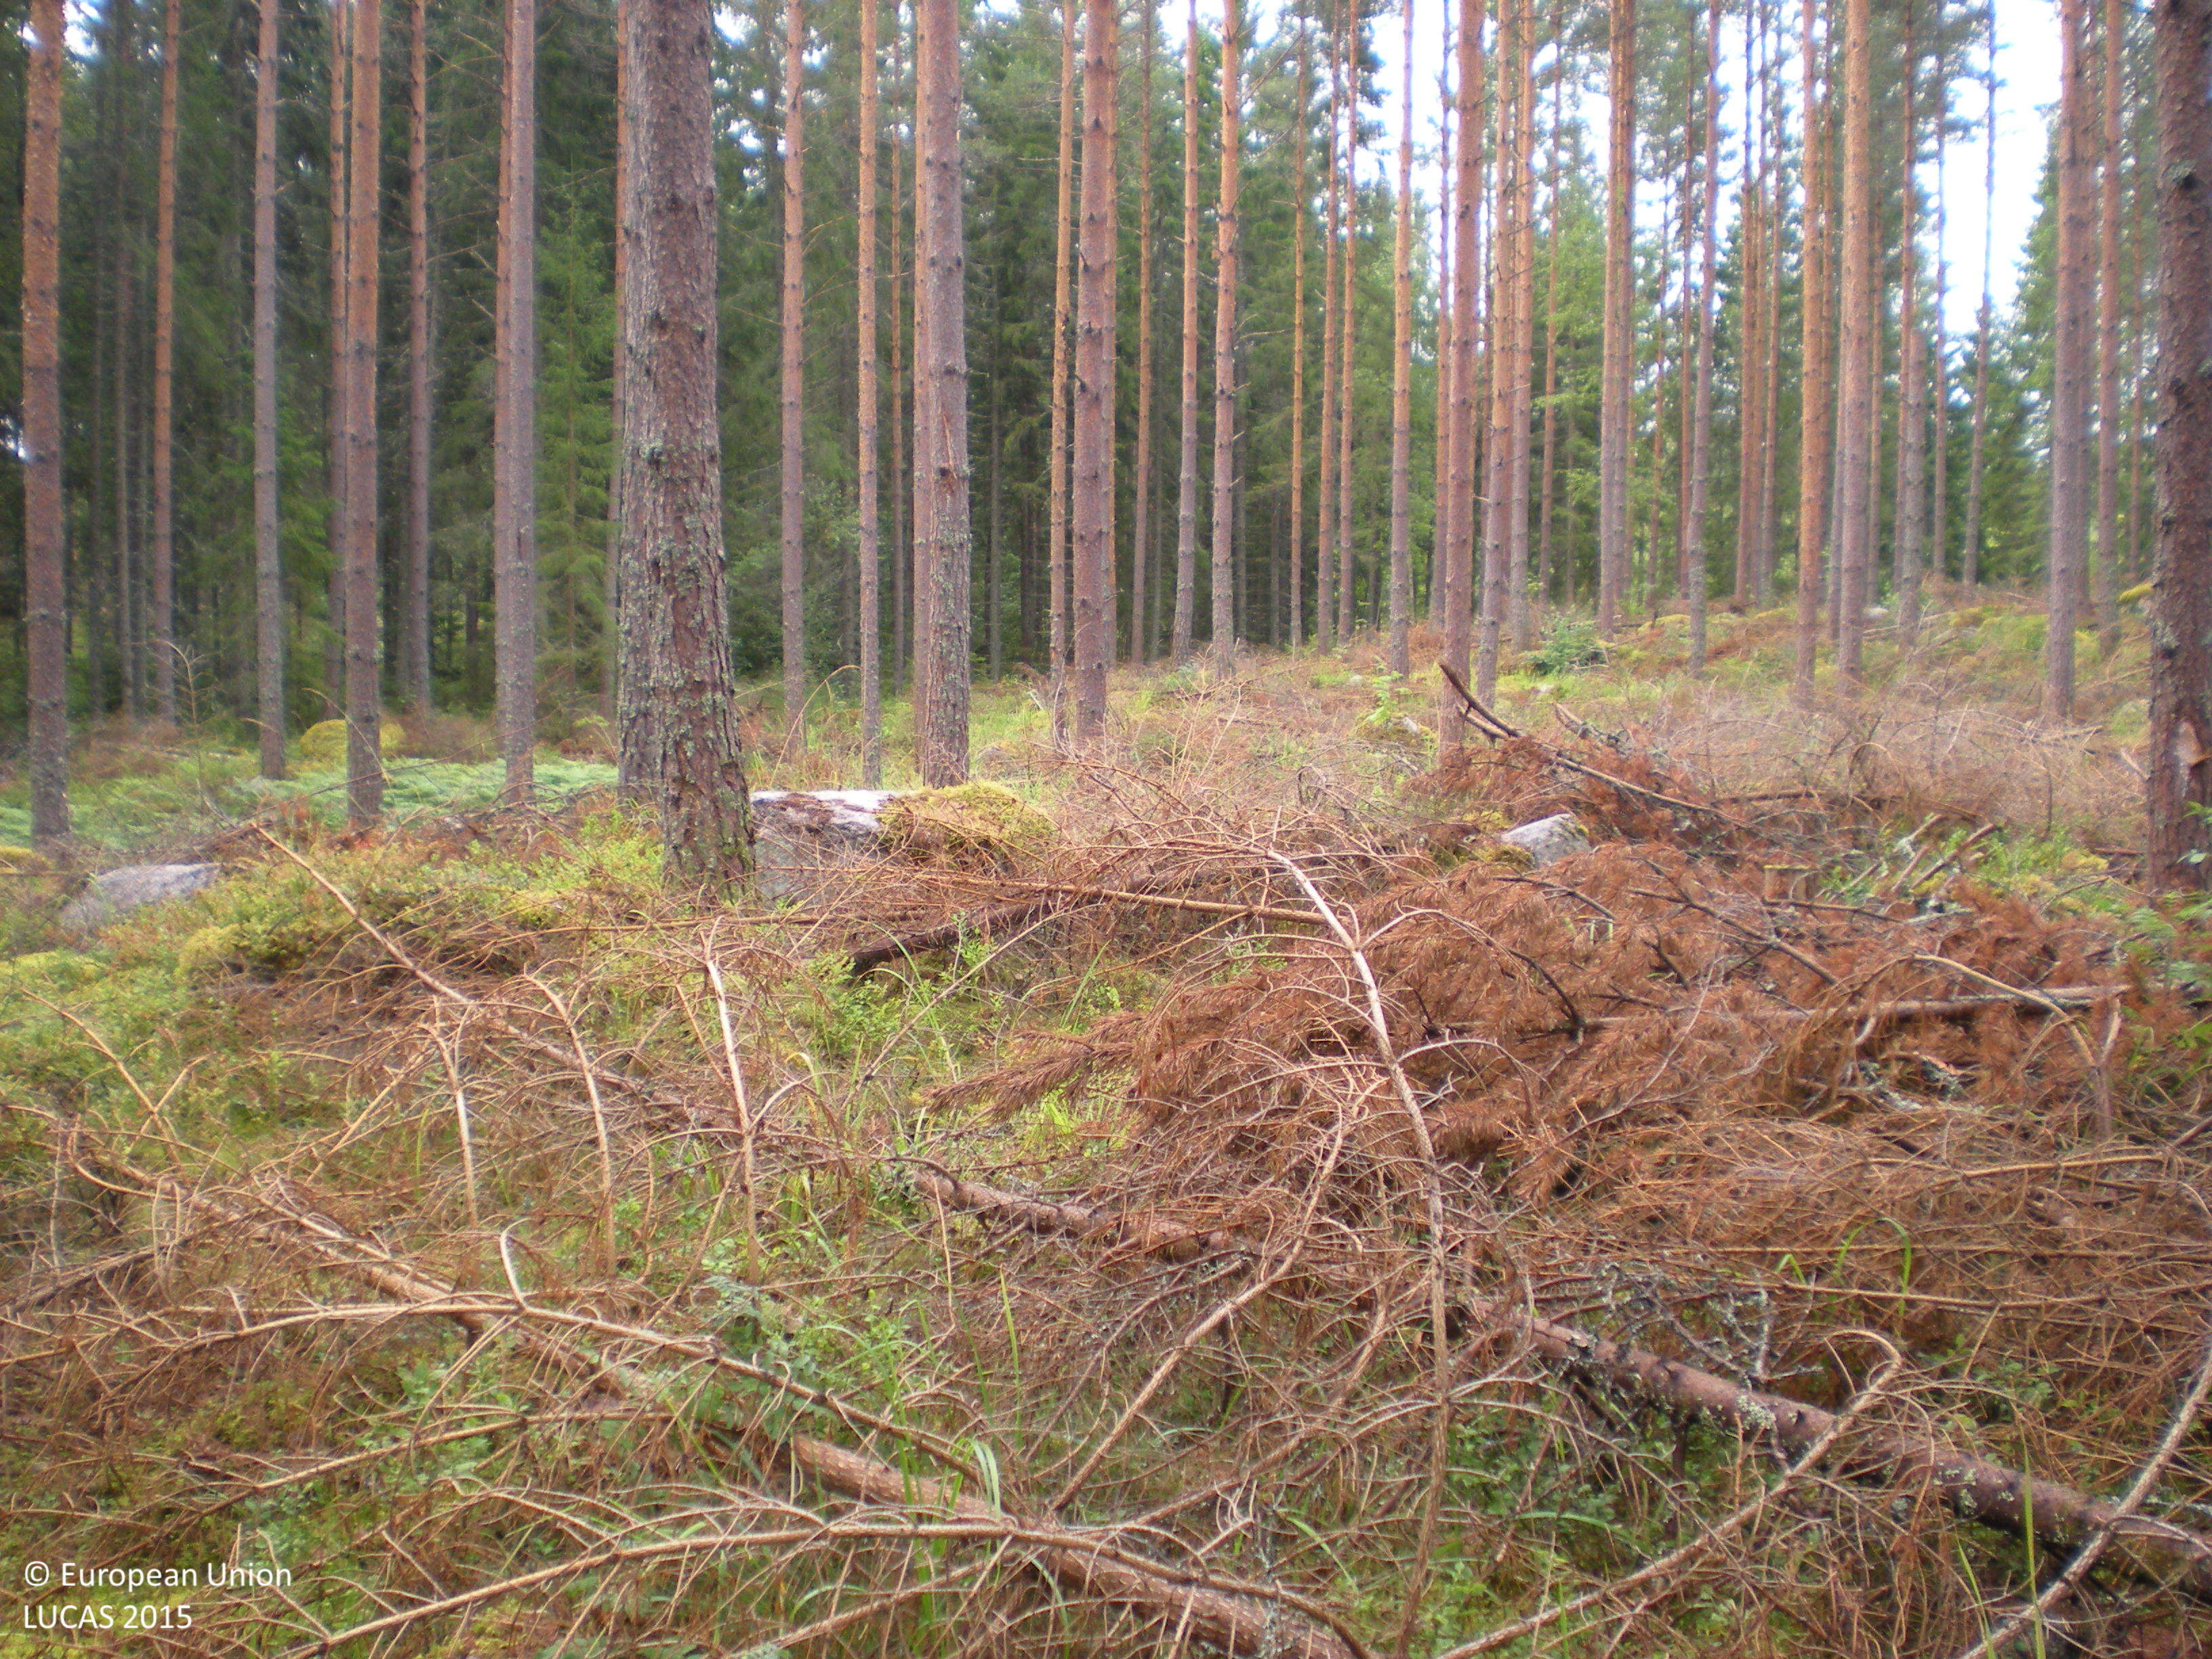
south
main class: Woodland
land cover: Pine dominated coniferous woodland
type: boreal forest
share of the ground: 50 - 75 %
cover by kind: coniferous forest trees 70 %, shrubs 10 %, herbaceous plants 5 %, lichens and mosses 5 %, consolidated bare surface 5 %
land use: Forestry
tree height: > 5 m
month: August
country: SE
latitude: 60.4683
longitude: 17.1743
